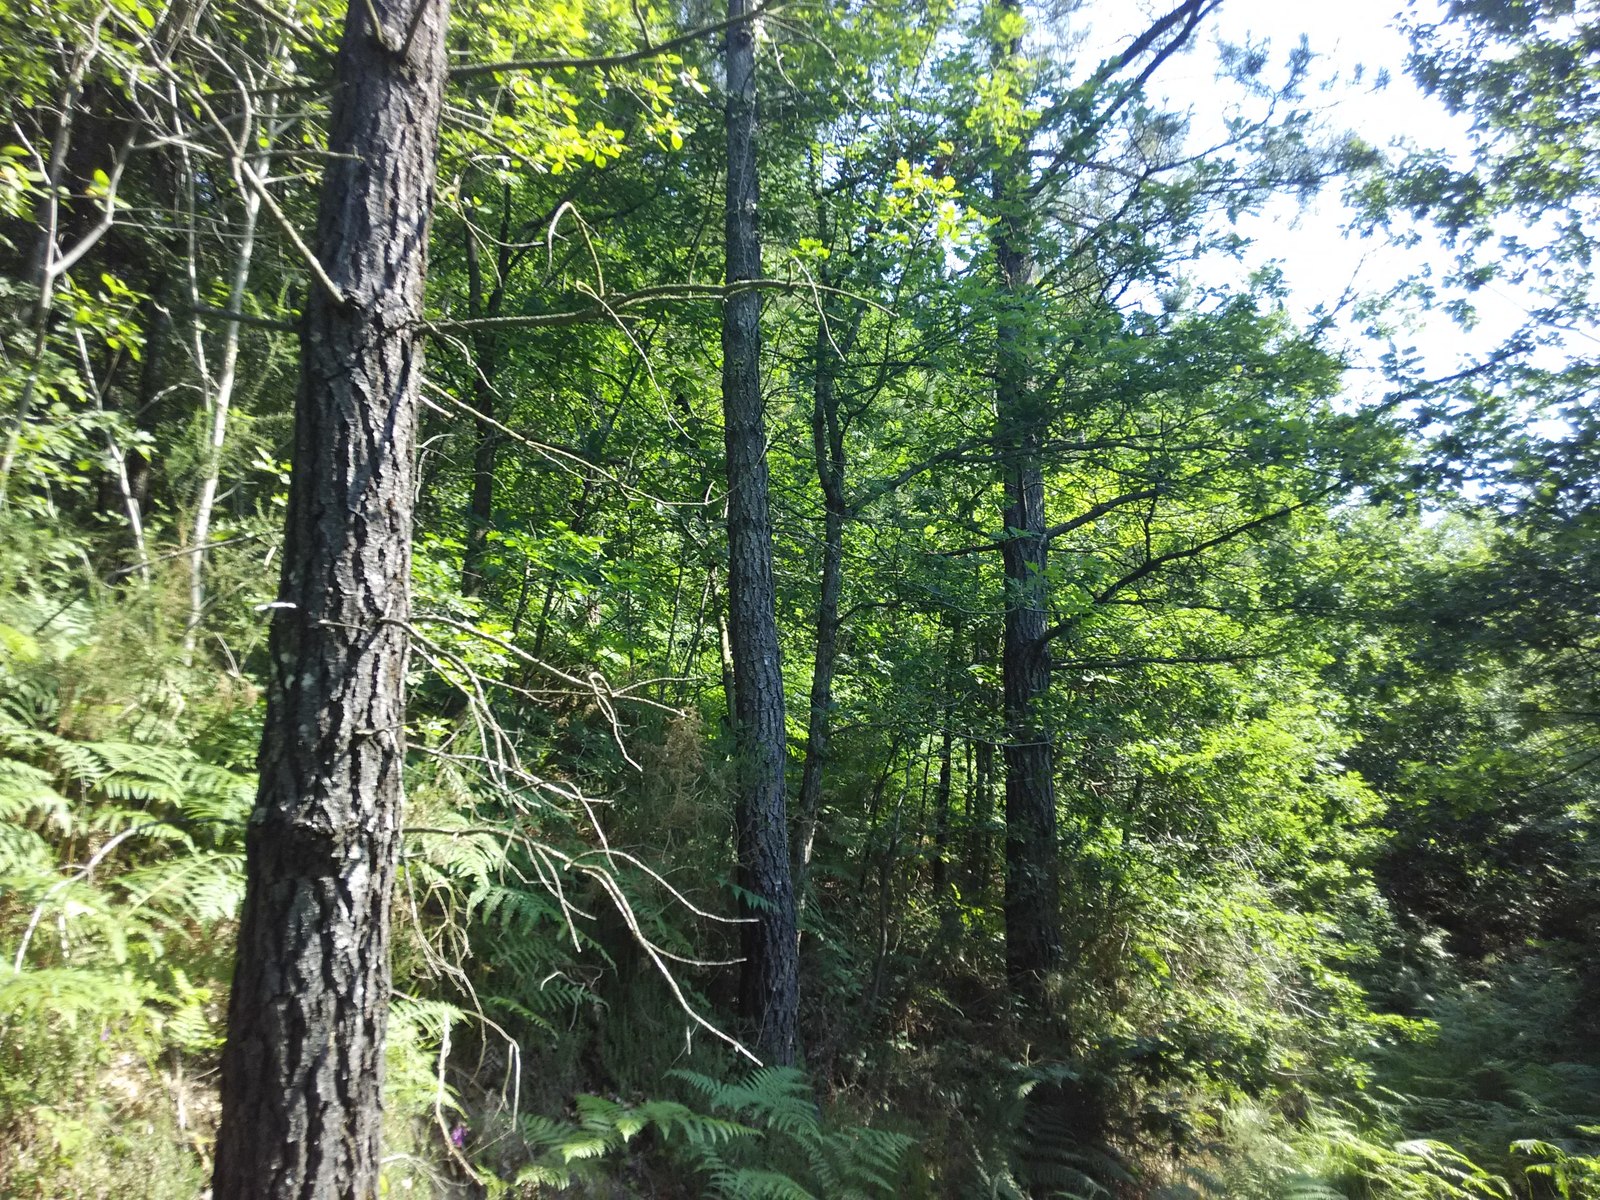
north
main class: Woodland
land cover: Other mixed woodland
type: broadleaved evergreen forest
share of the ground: > 75 %
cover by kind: coniferous forest trees 45 %, broadleaved forest trees 40 %, shrubs 15 %
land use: Forestry
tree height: > 5 m
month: June
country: ES
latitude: 43.0549
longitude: -2.4136
